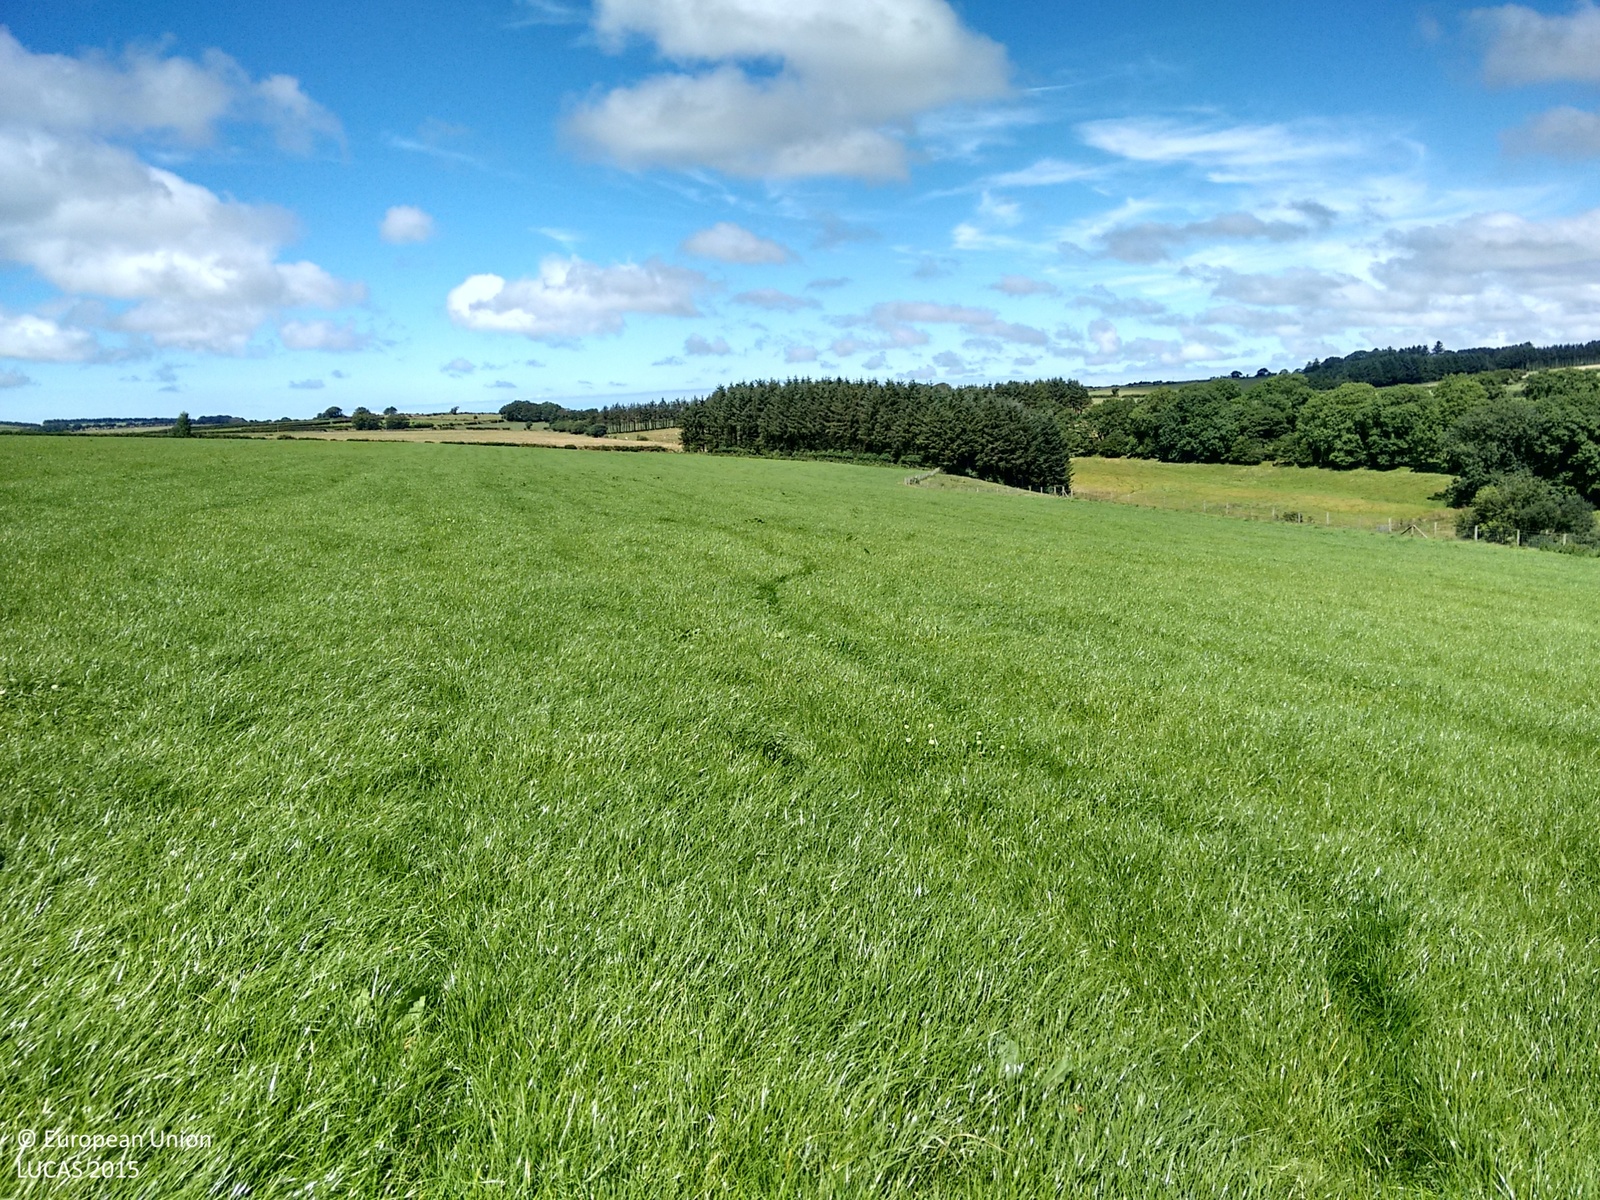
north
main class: Cropland
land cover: Temporary grasslands
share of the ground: > 75 %
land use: Agriculture (excluding fallow land and kitchen gardens)
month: August
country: GB
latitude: 52.1287
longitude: -4.2849
